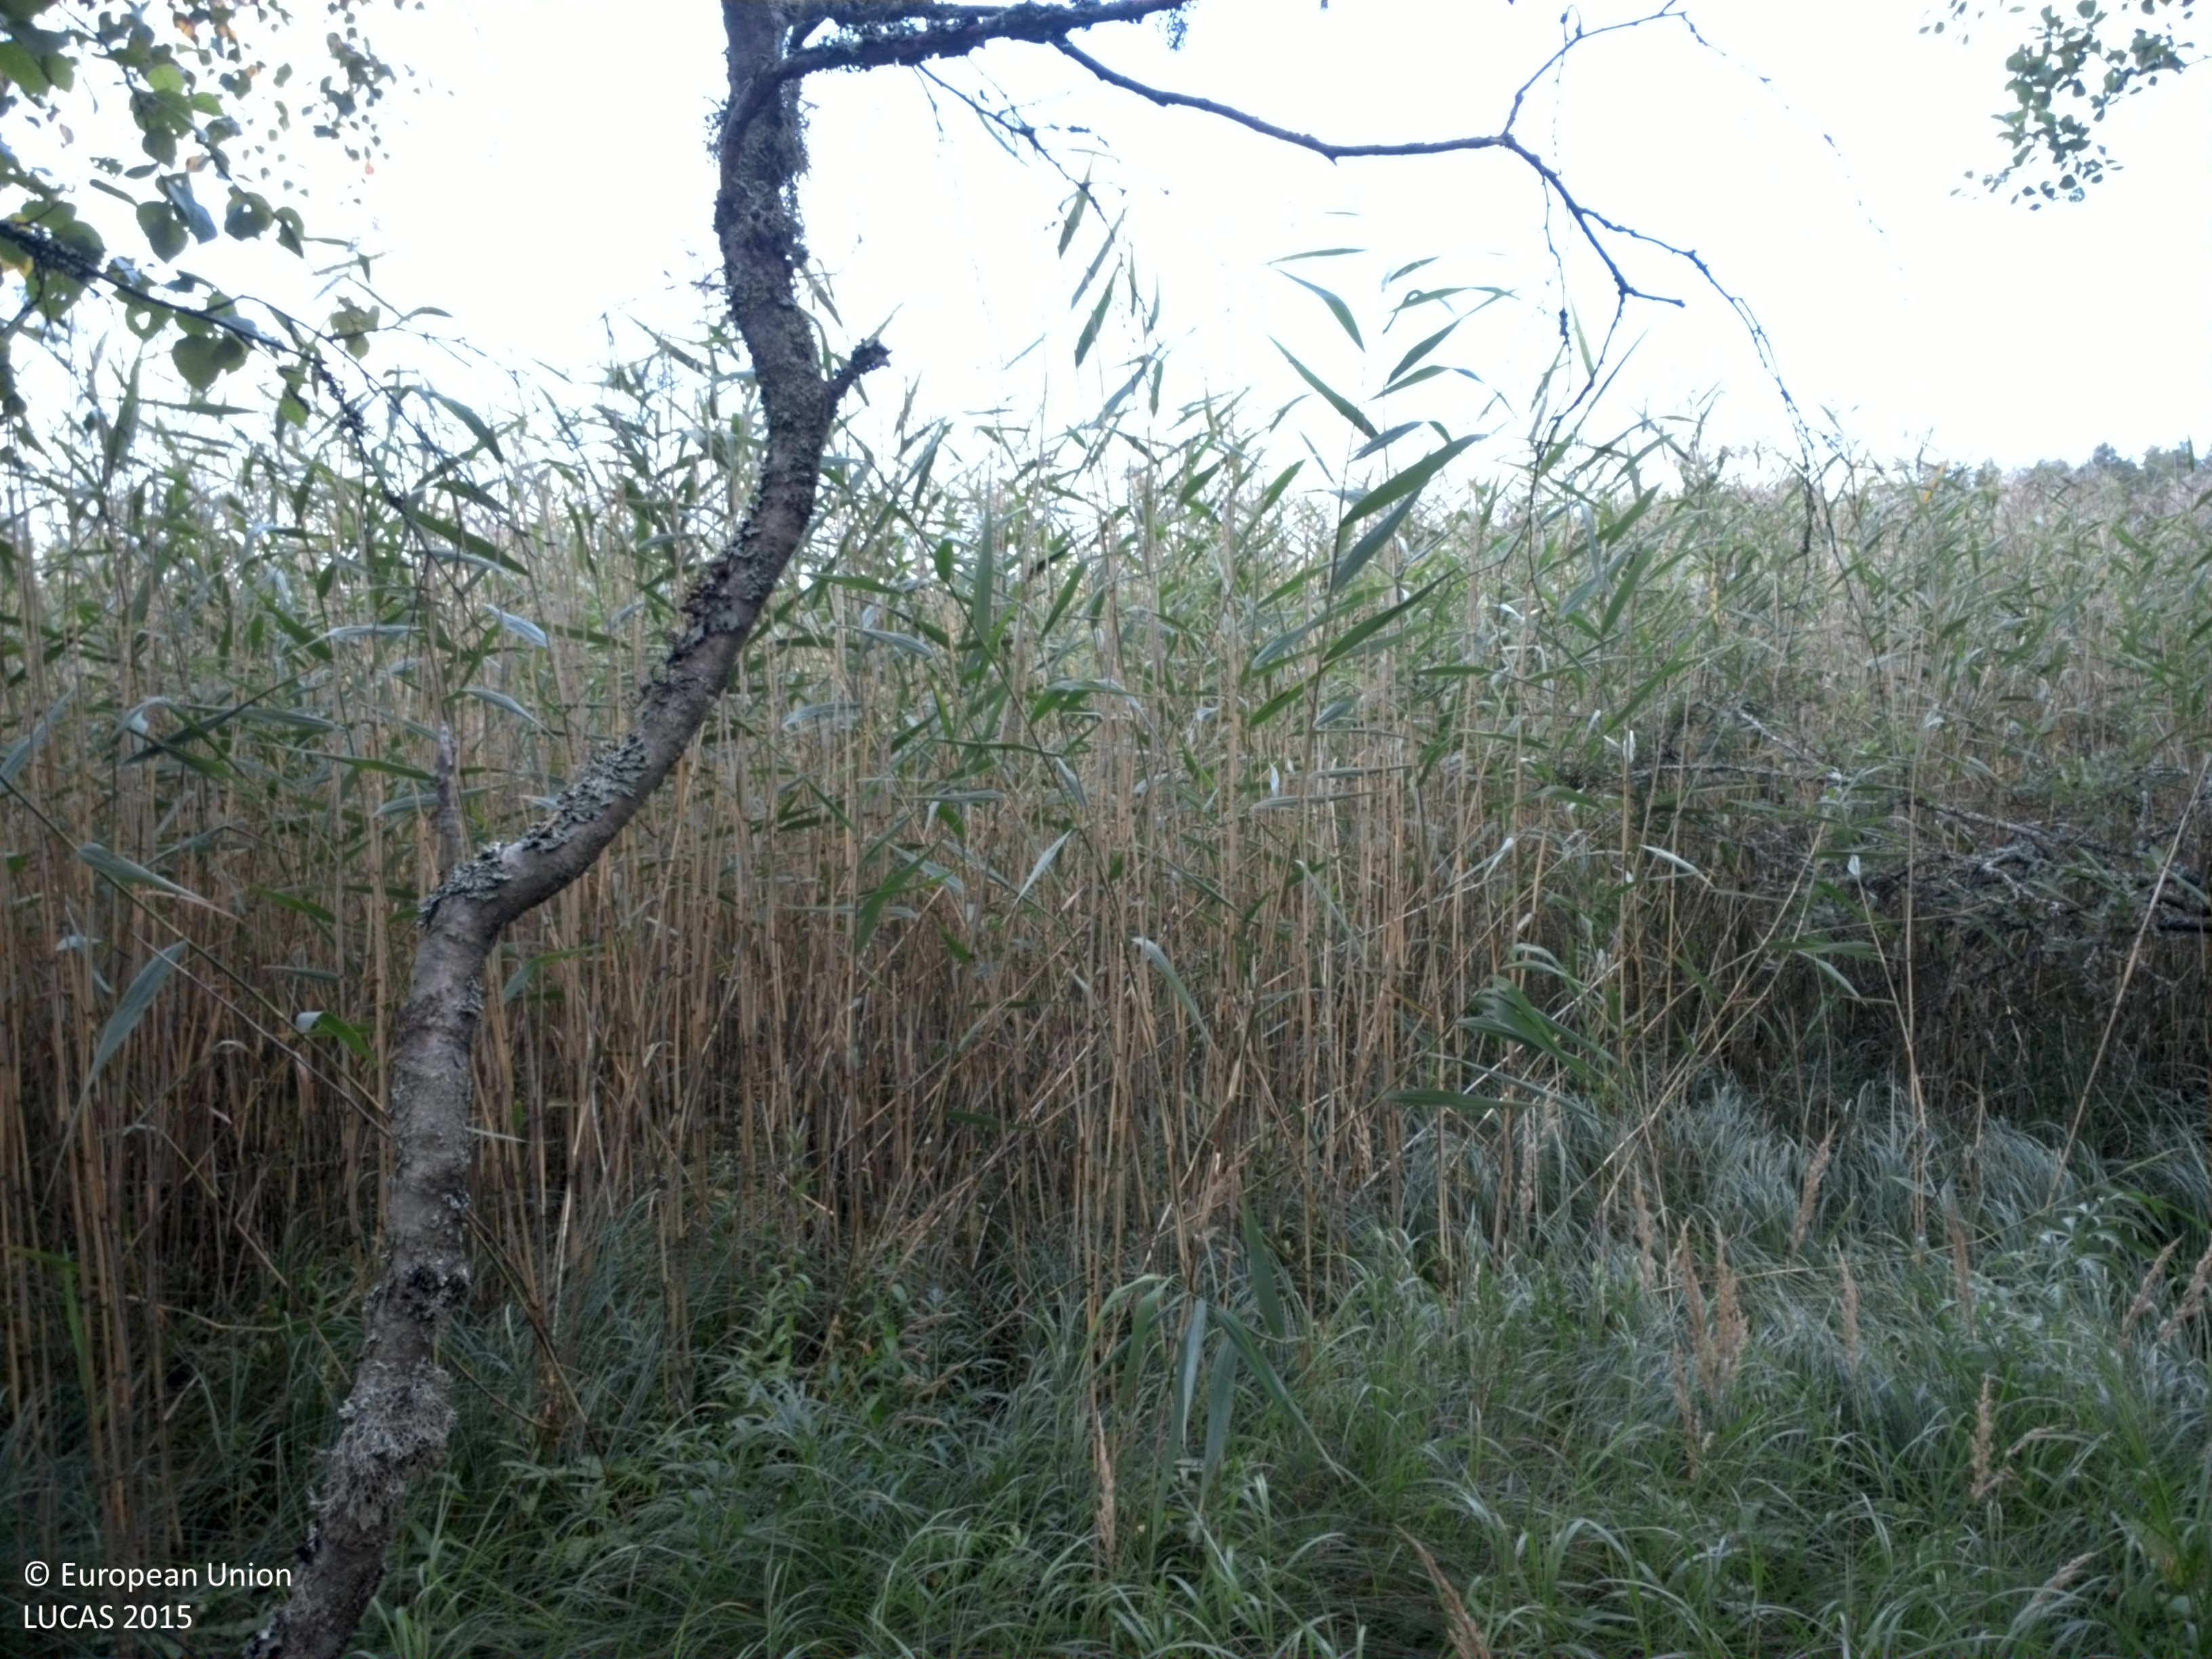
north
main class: Woodland
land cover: Pine dominated coniferous woodland
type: boreal forest
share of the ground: 50 - 75 %
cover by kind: coniferous forest trees 55 %, shrubs 20 %, broadleaved forest trees 10 %, lichens and mosses 10 %, herbaceous plants 5 %
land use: Forestry
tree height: > 5 m
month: August
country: SE
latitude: 59.5801
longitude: 13.4445
